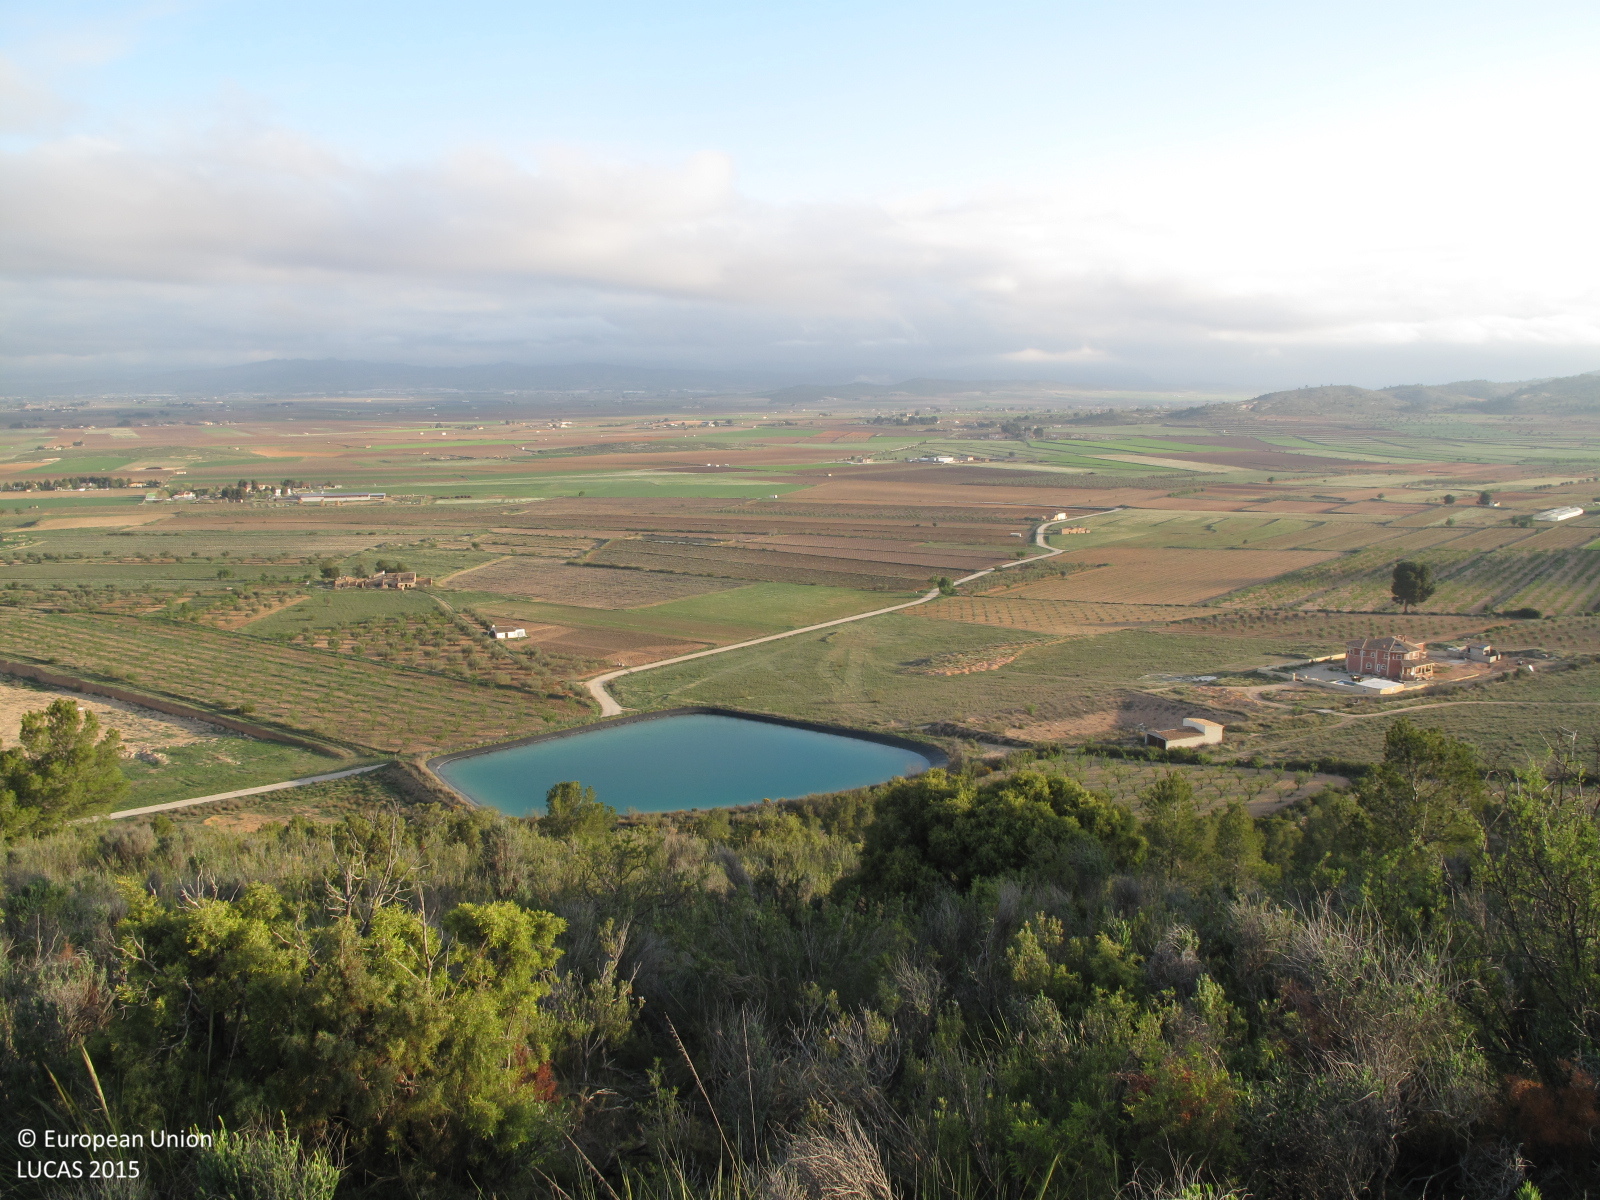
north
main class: Shrubland
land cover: Shrubland with sparse tree cover
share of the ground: > 75 %
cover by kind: shrubs 70 %, herbaceous plants 20 %, coniferous forest trees 5 %, consolidated bare surface 5 %
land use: Semi-natural and natural areas not in use
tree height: < 5 m
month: April
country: ES
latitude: 38.5290
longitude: -1.0364
